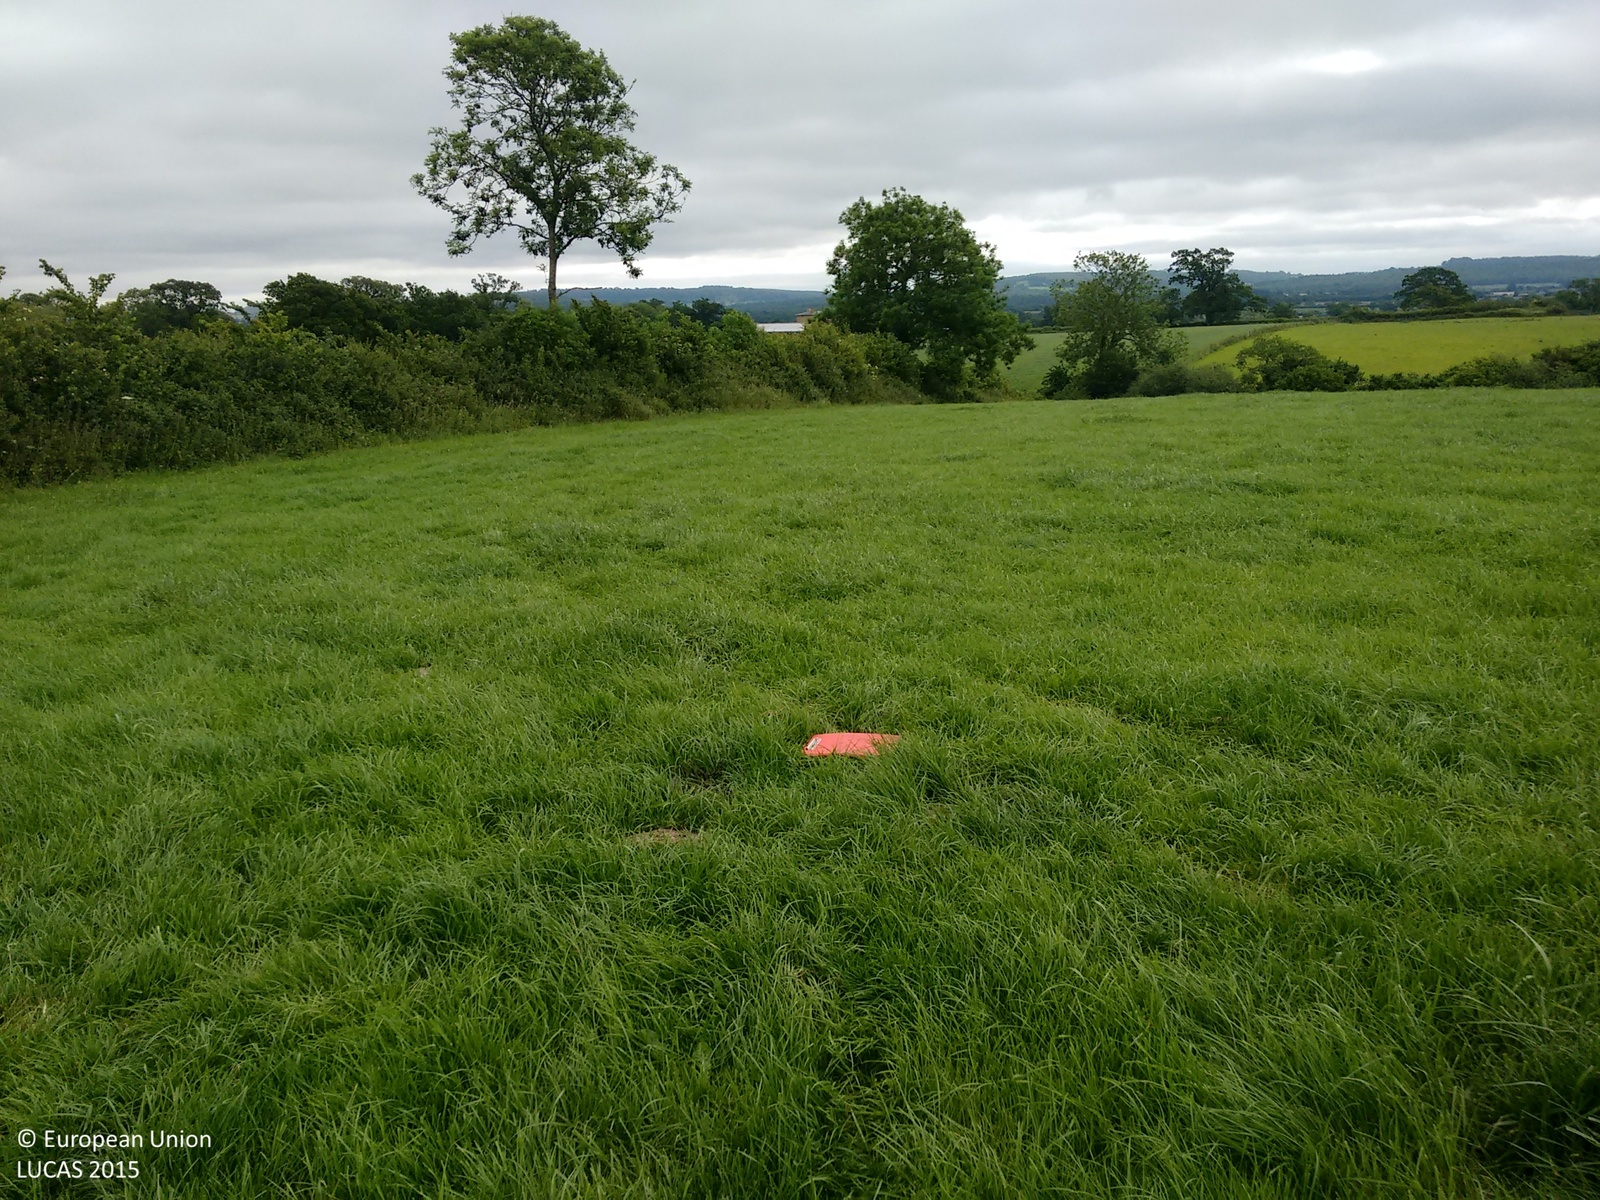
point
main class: Grassland
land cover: Grassland without tree/shrub cover
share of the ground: > 75 %
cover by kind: herbaceous plants 100 %
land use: Agriculture (excluding fallow land and kitchen gardens)
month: June
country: GB
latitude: 51.2010
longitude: -2.3579
